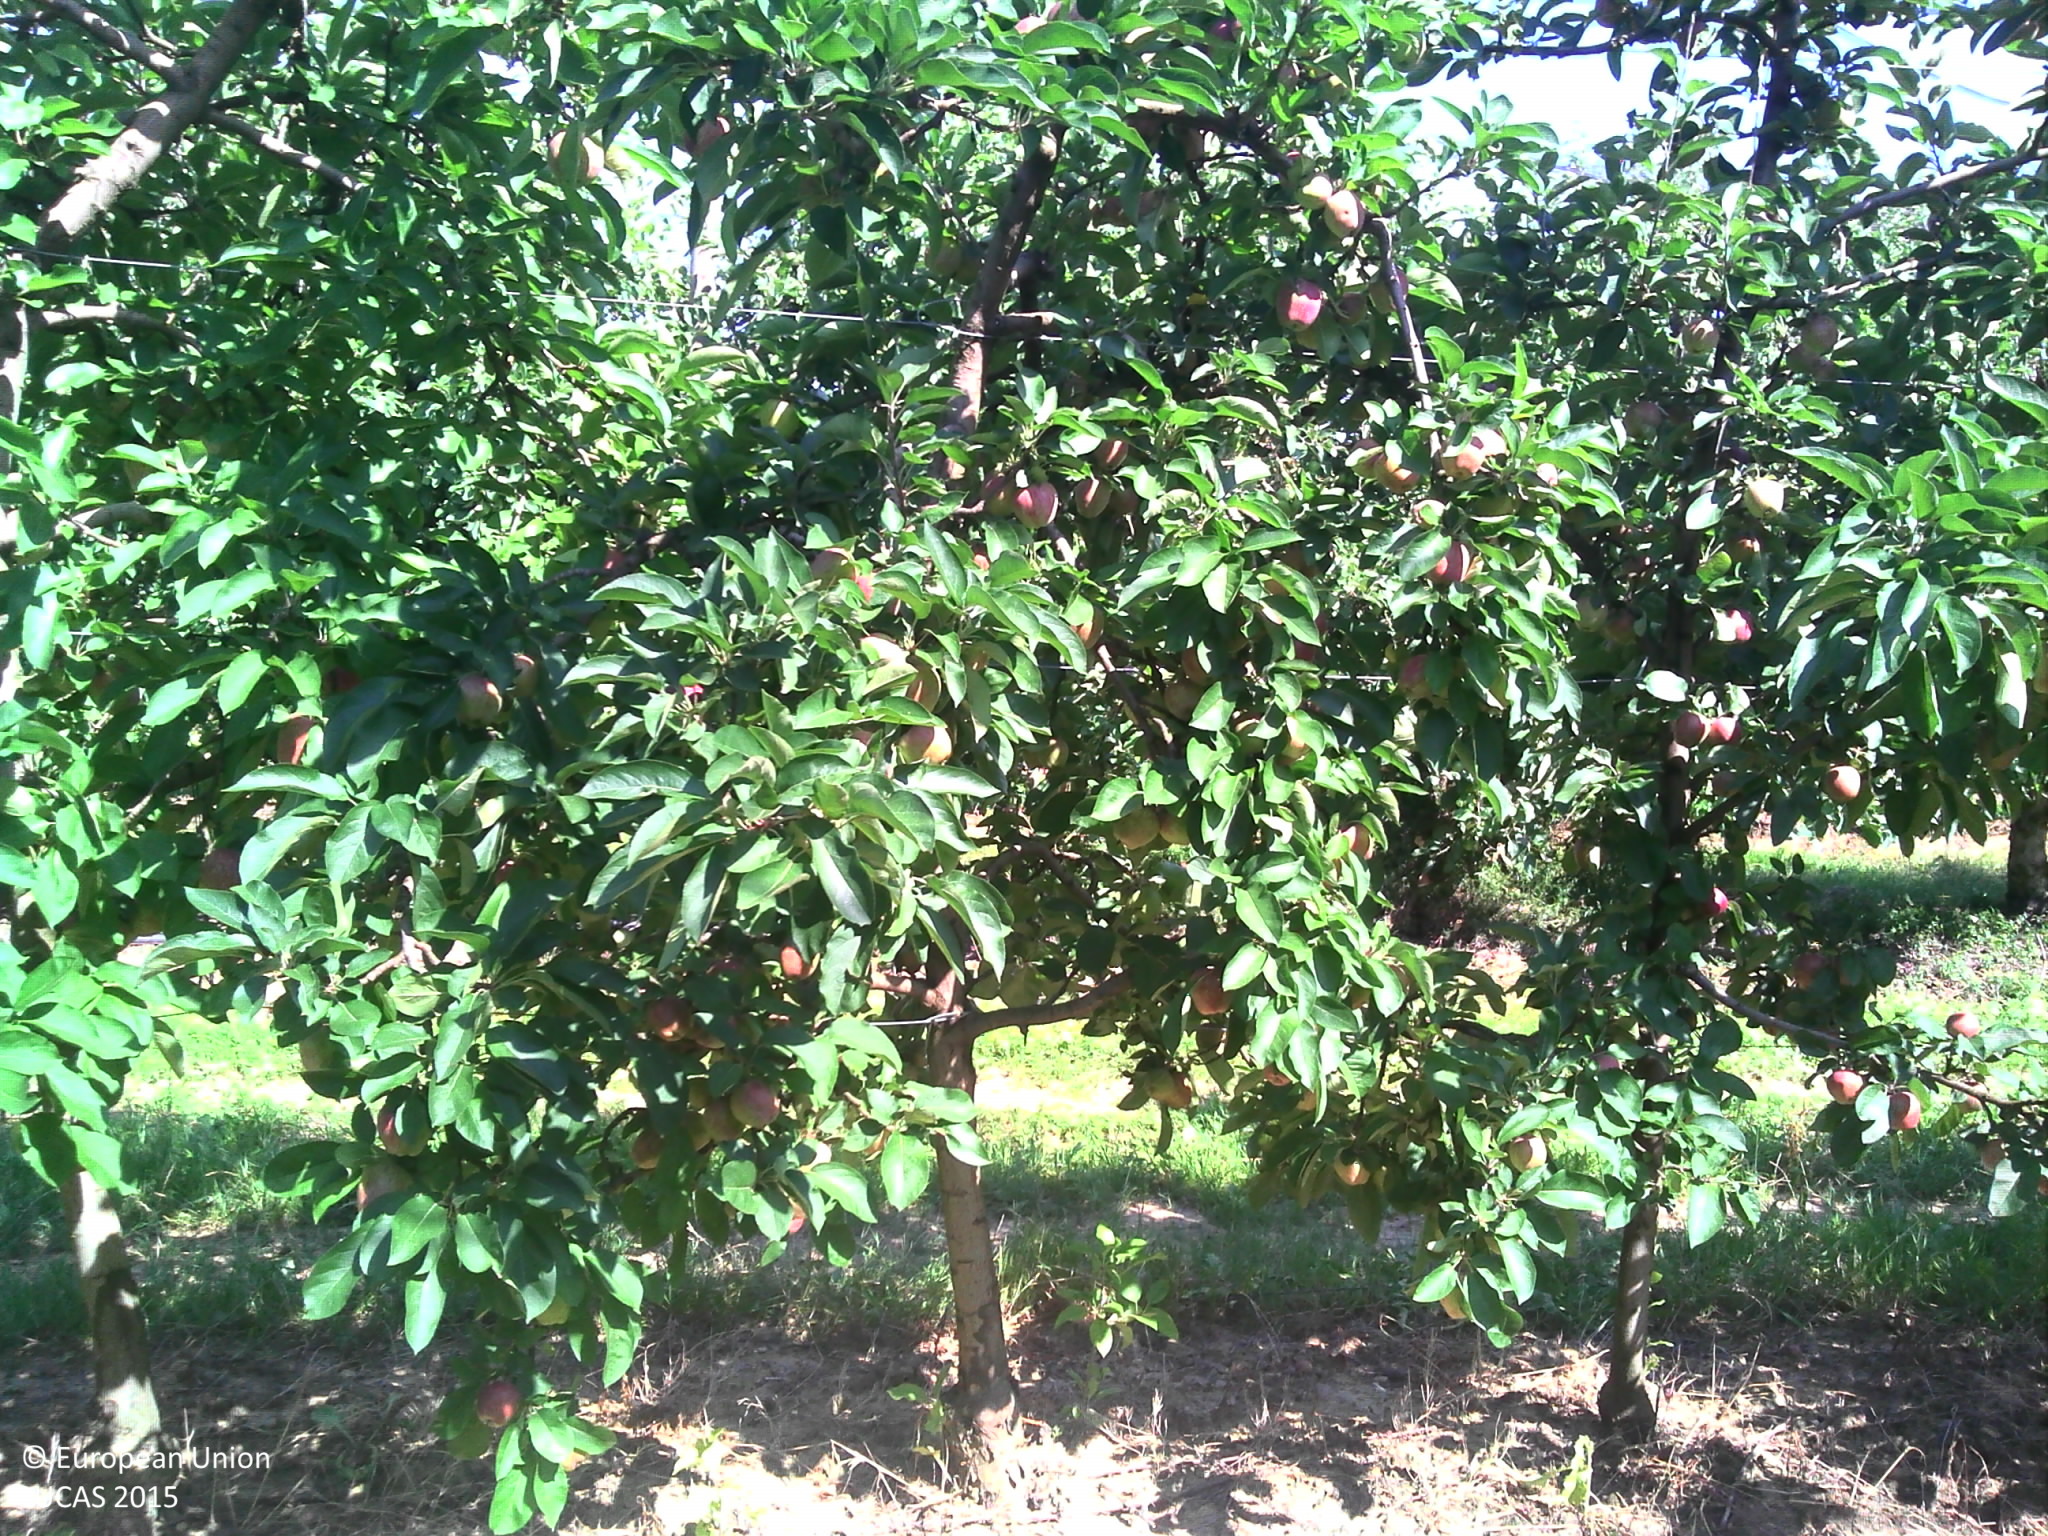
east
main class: Cropland
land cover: Apple fruit
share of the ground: 25 - 50 %
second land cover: Grassland without tree/shrub cover
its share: 25 - 50 %
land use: Agriculture (excluding fallow land and kitchen gardens)
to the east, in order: Apple fruit; Grassland without tree/shrub cover
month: July
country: FR
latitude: 44.0472
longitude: 0.9741
